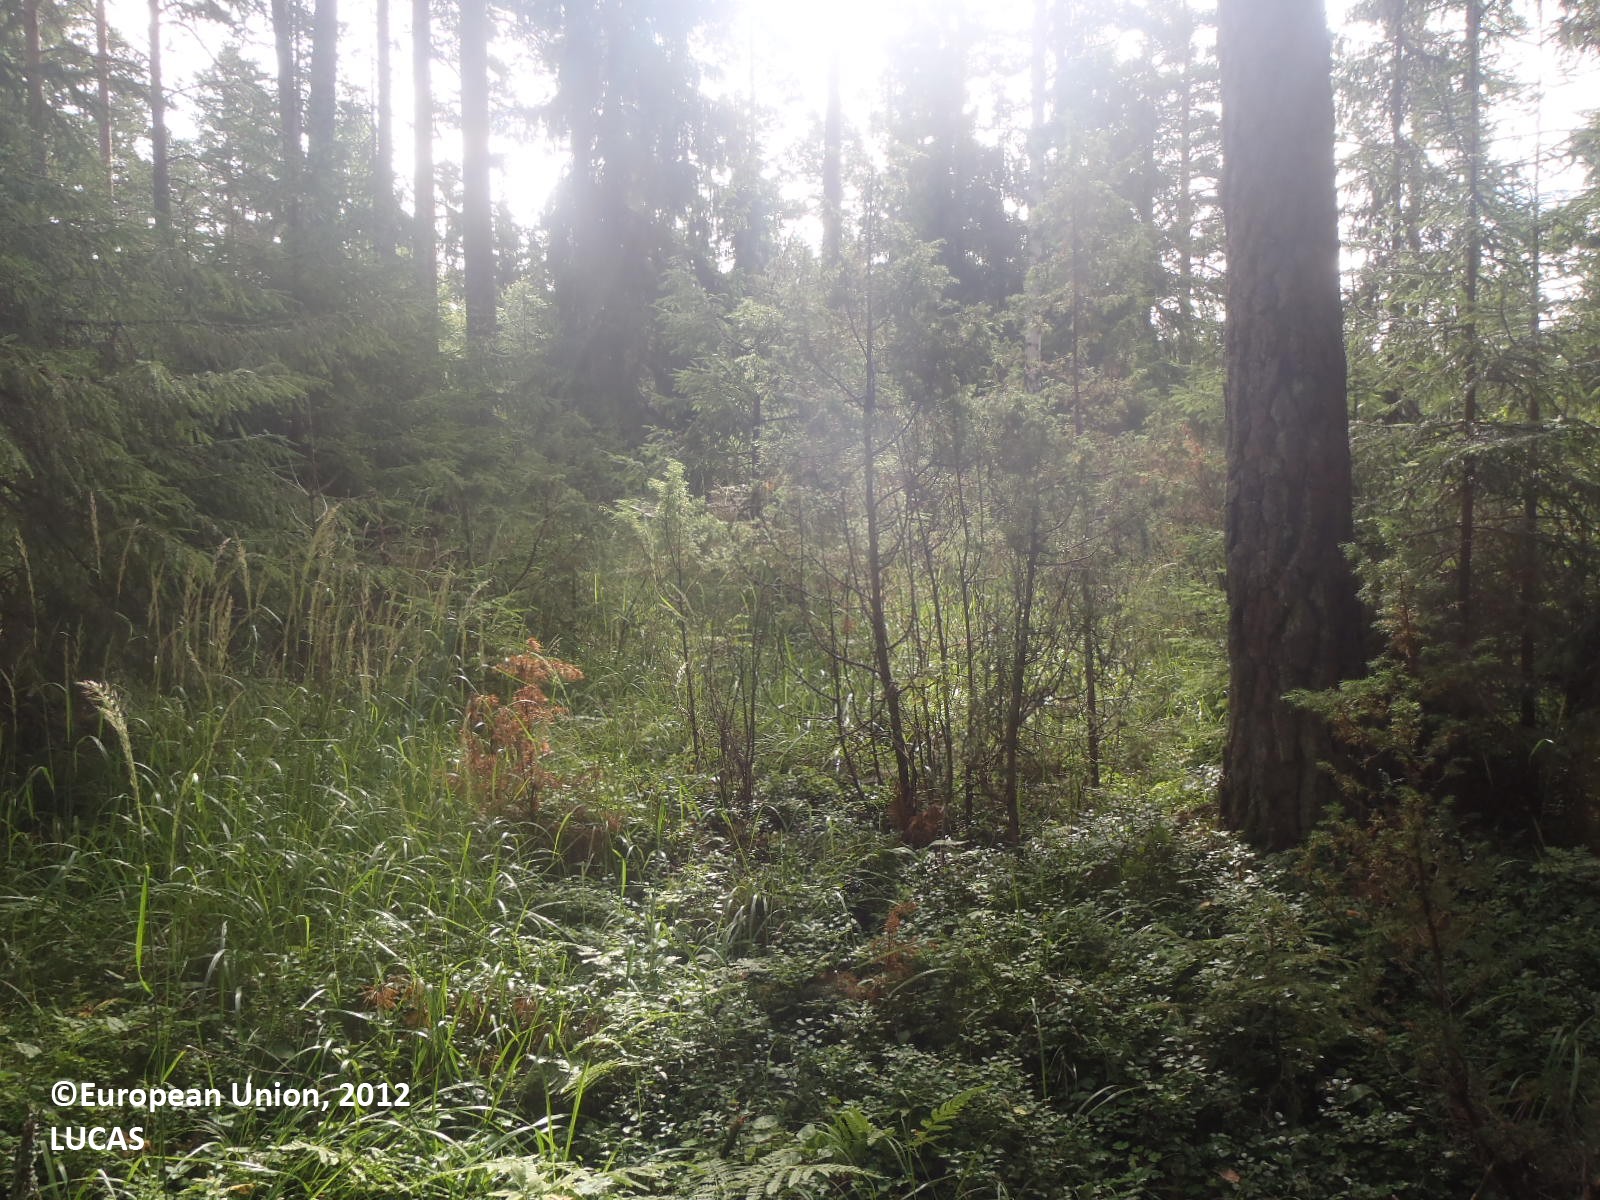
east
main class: Woodland
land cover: Other coniferous woodland
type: boreal forest
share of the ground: 50 - 75 %
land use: Forestry
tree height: > 5 m
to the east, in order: Other coniferous woodland; Spruce dominated coniferous woodland; Pine dominated coniferous woodland; Spruce dominated coniferous woodland; Grassland with sparse tree/shrub cover; Spruce dominated coniferous woodland; Spruce dominated mixed woodland
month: July
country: FI
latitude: 61.0969
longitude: 21.9099
